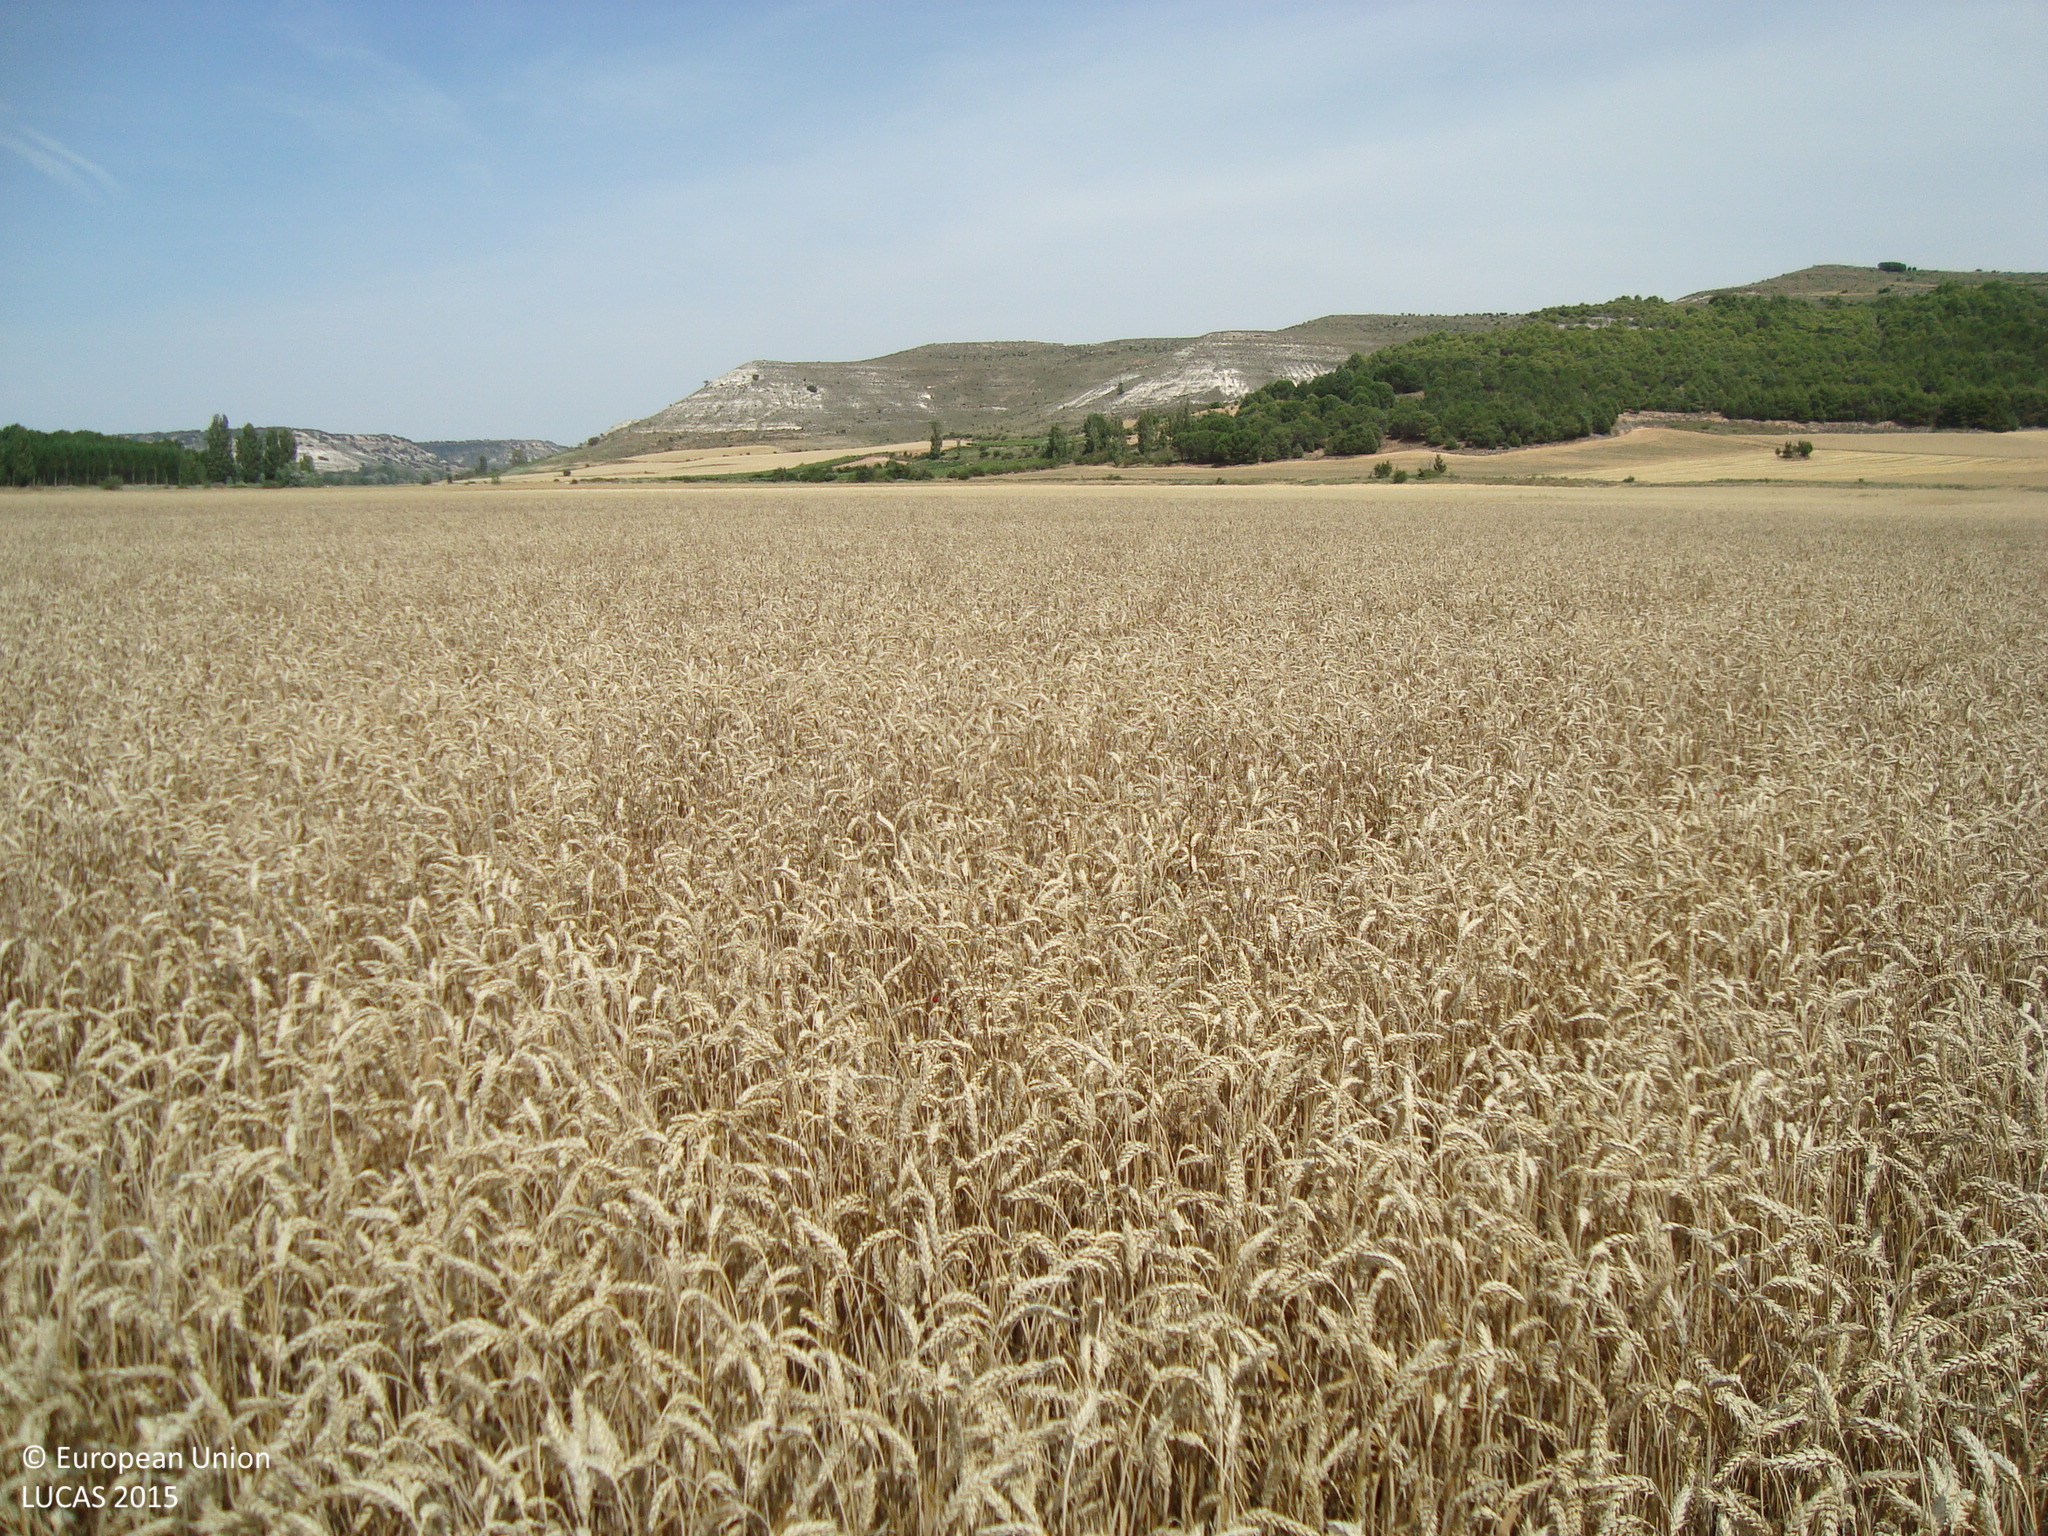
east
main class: Cropland
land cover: Common wheat
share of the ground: > 75 %
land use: Agriculture (excluding fallow land and kitchen gardens)
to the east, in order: Common wheat
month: July
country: ES
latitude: 41.7965
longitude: -4.0559
